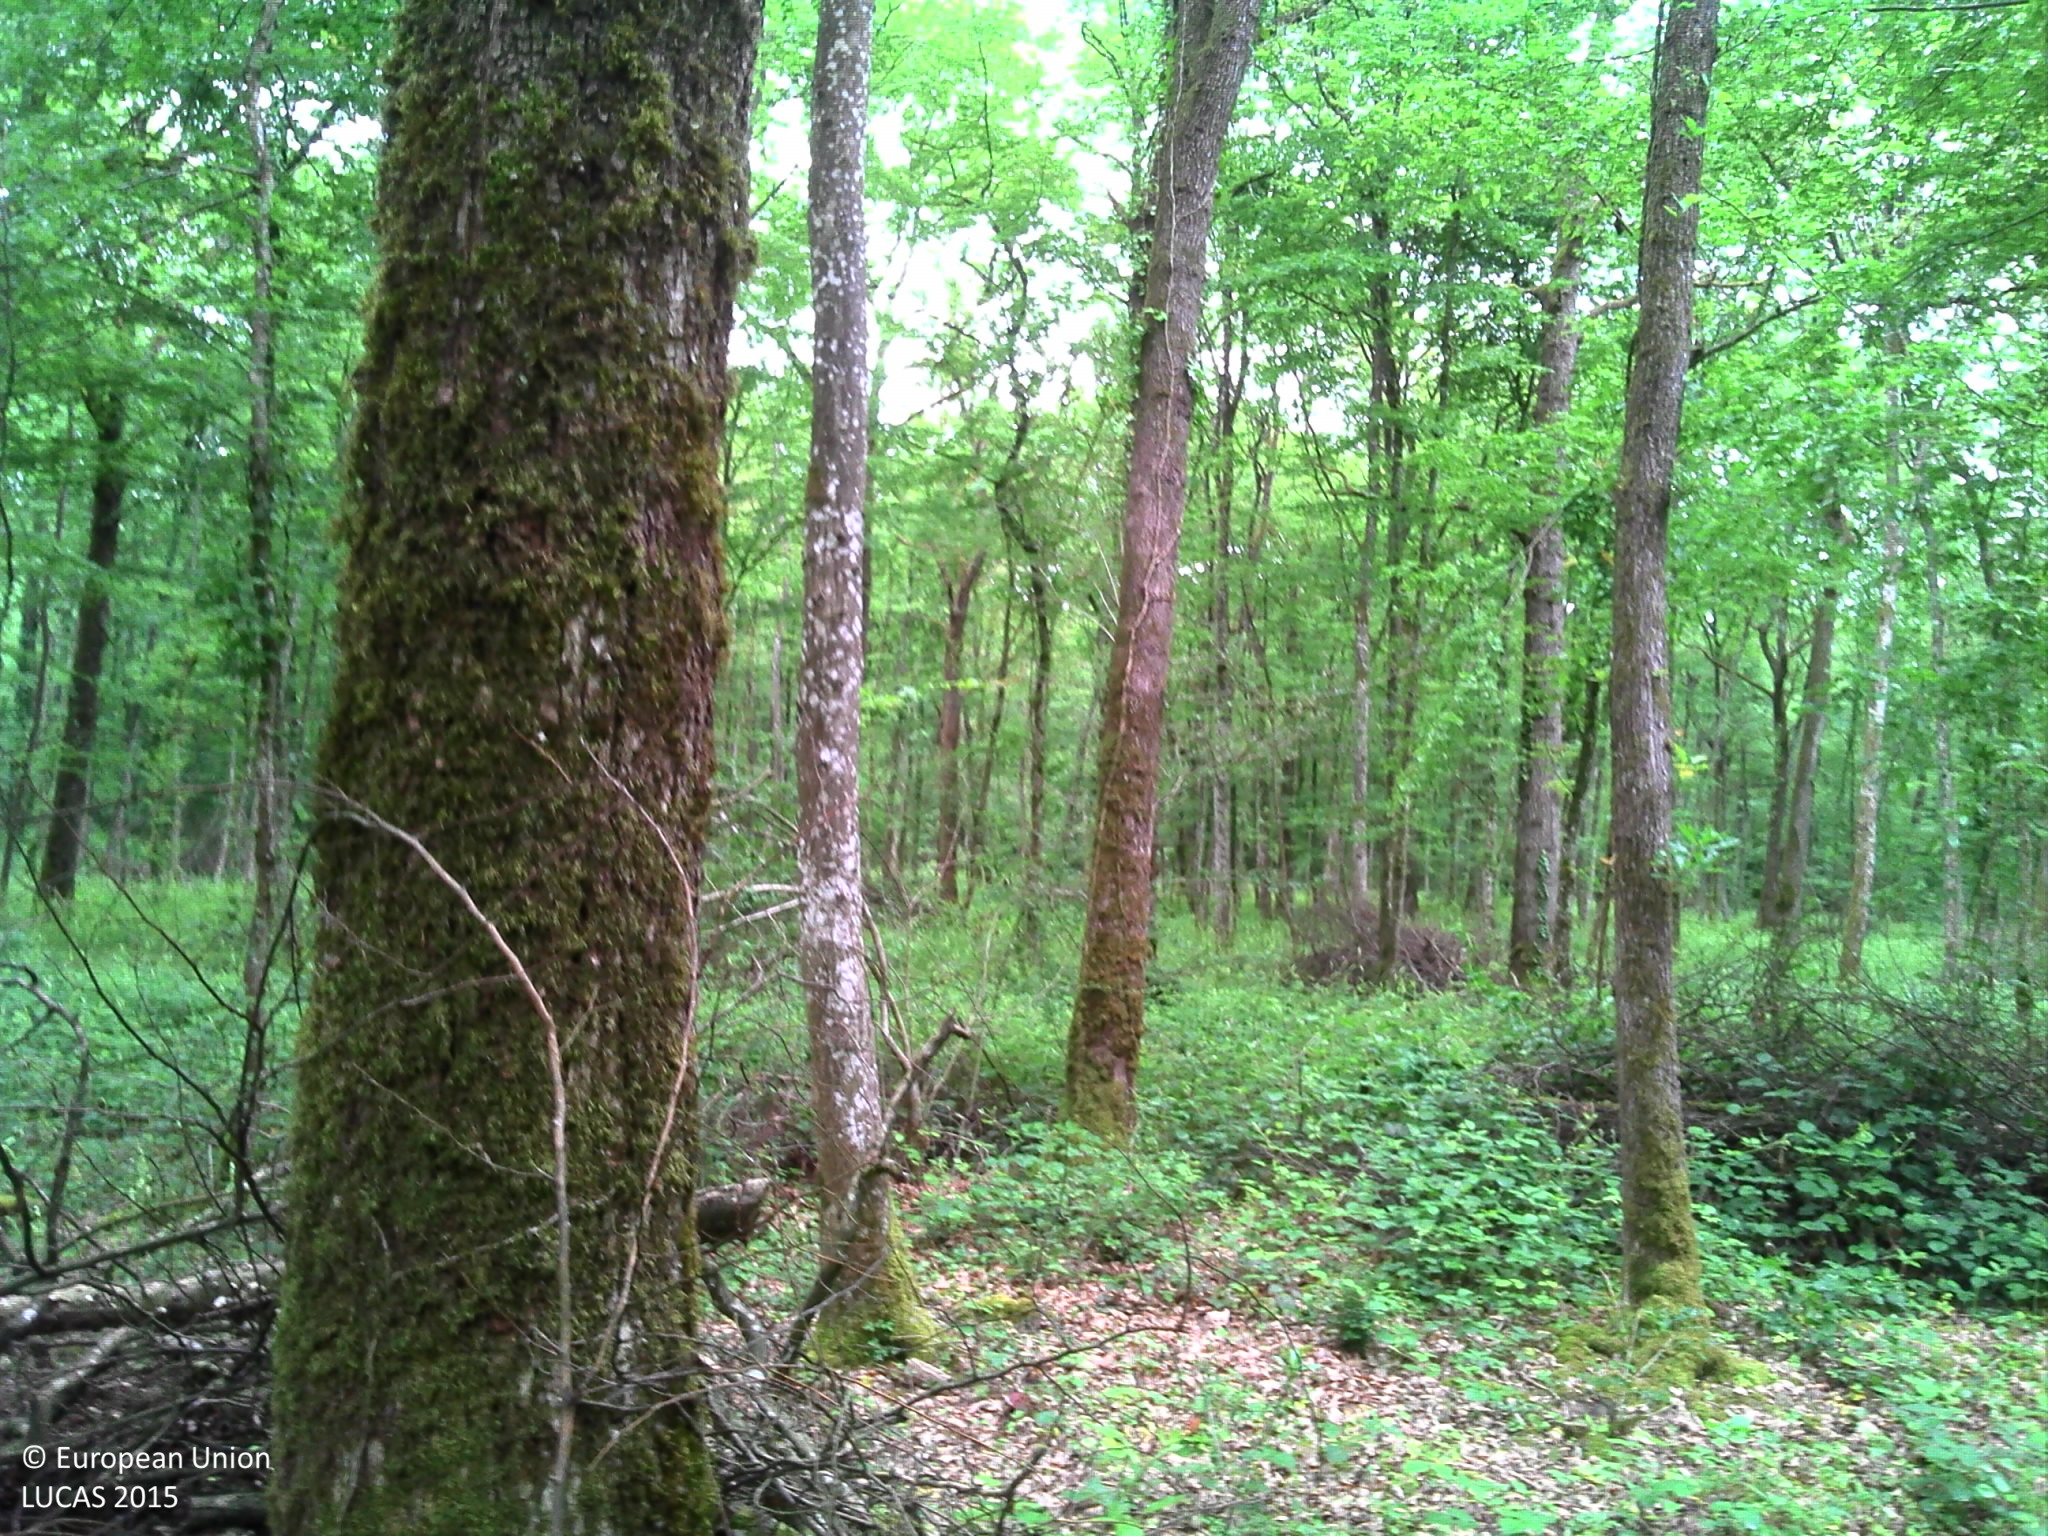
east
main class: Woodland
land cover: Broadleaved woodland
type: mesophytic deciduous forest
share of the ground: > 75 %
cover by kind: broadleaved forest trees 90 %, herbaceous plants 5 %, lichens and mosses 5 %
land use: Forestry
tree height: > 5 m
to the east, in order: Broadleaved woodland; Tracks; Broadleaved woodland; Tracks; Broadleaved woodland
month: June
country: FR
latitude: 47.3927
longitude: 5.0853
